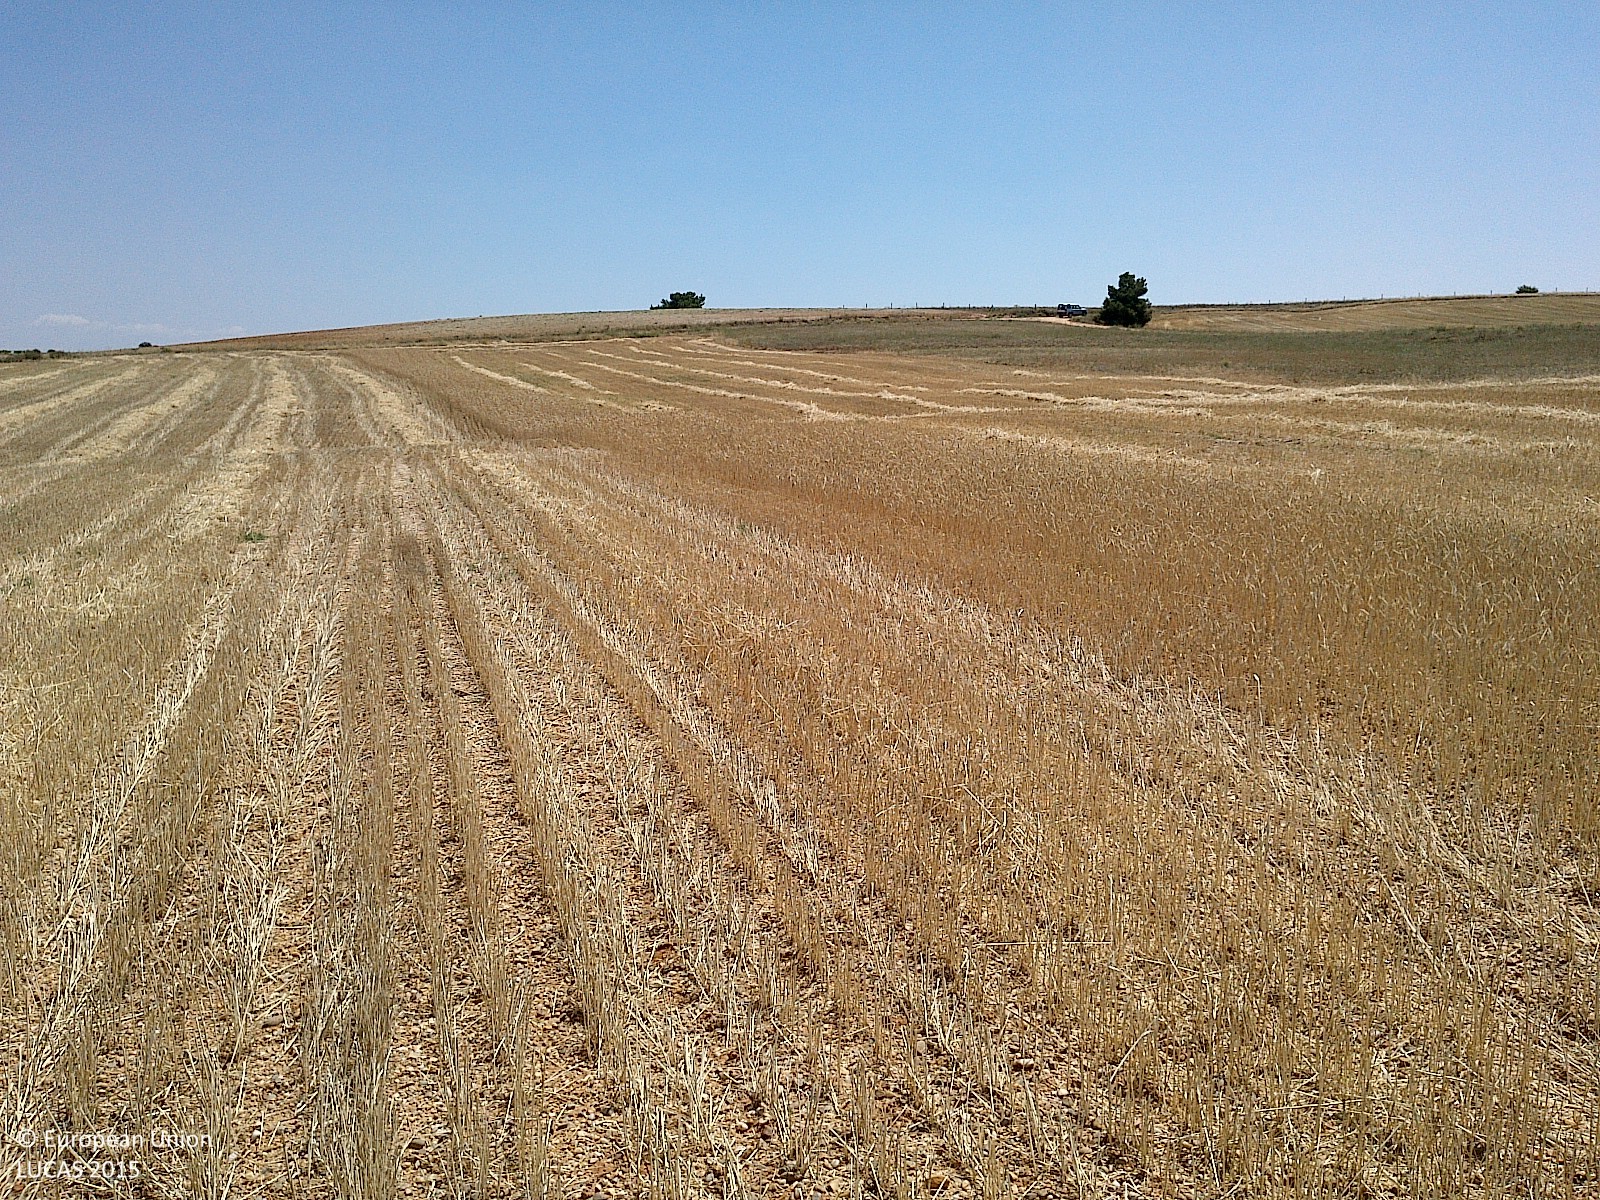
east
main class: Cropland
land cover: Common wheat
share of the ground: < 10 %
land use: Agriculture (excluding fallow land and kitchen gardens)
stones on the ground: 10 - 25 %
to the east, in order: Common wheat; Spontaneously vegetated surfaces; Tracks; Grass margins; Other bare soil; Fences; Grassland with sparse tree/shrub cover
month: July
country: ES
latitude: 41.7411
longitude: -3.2622
